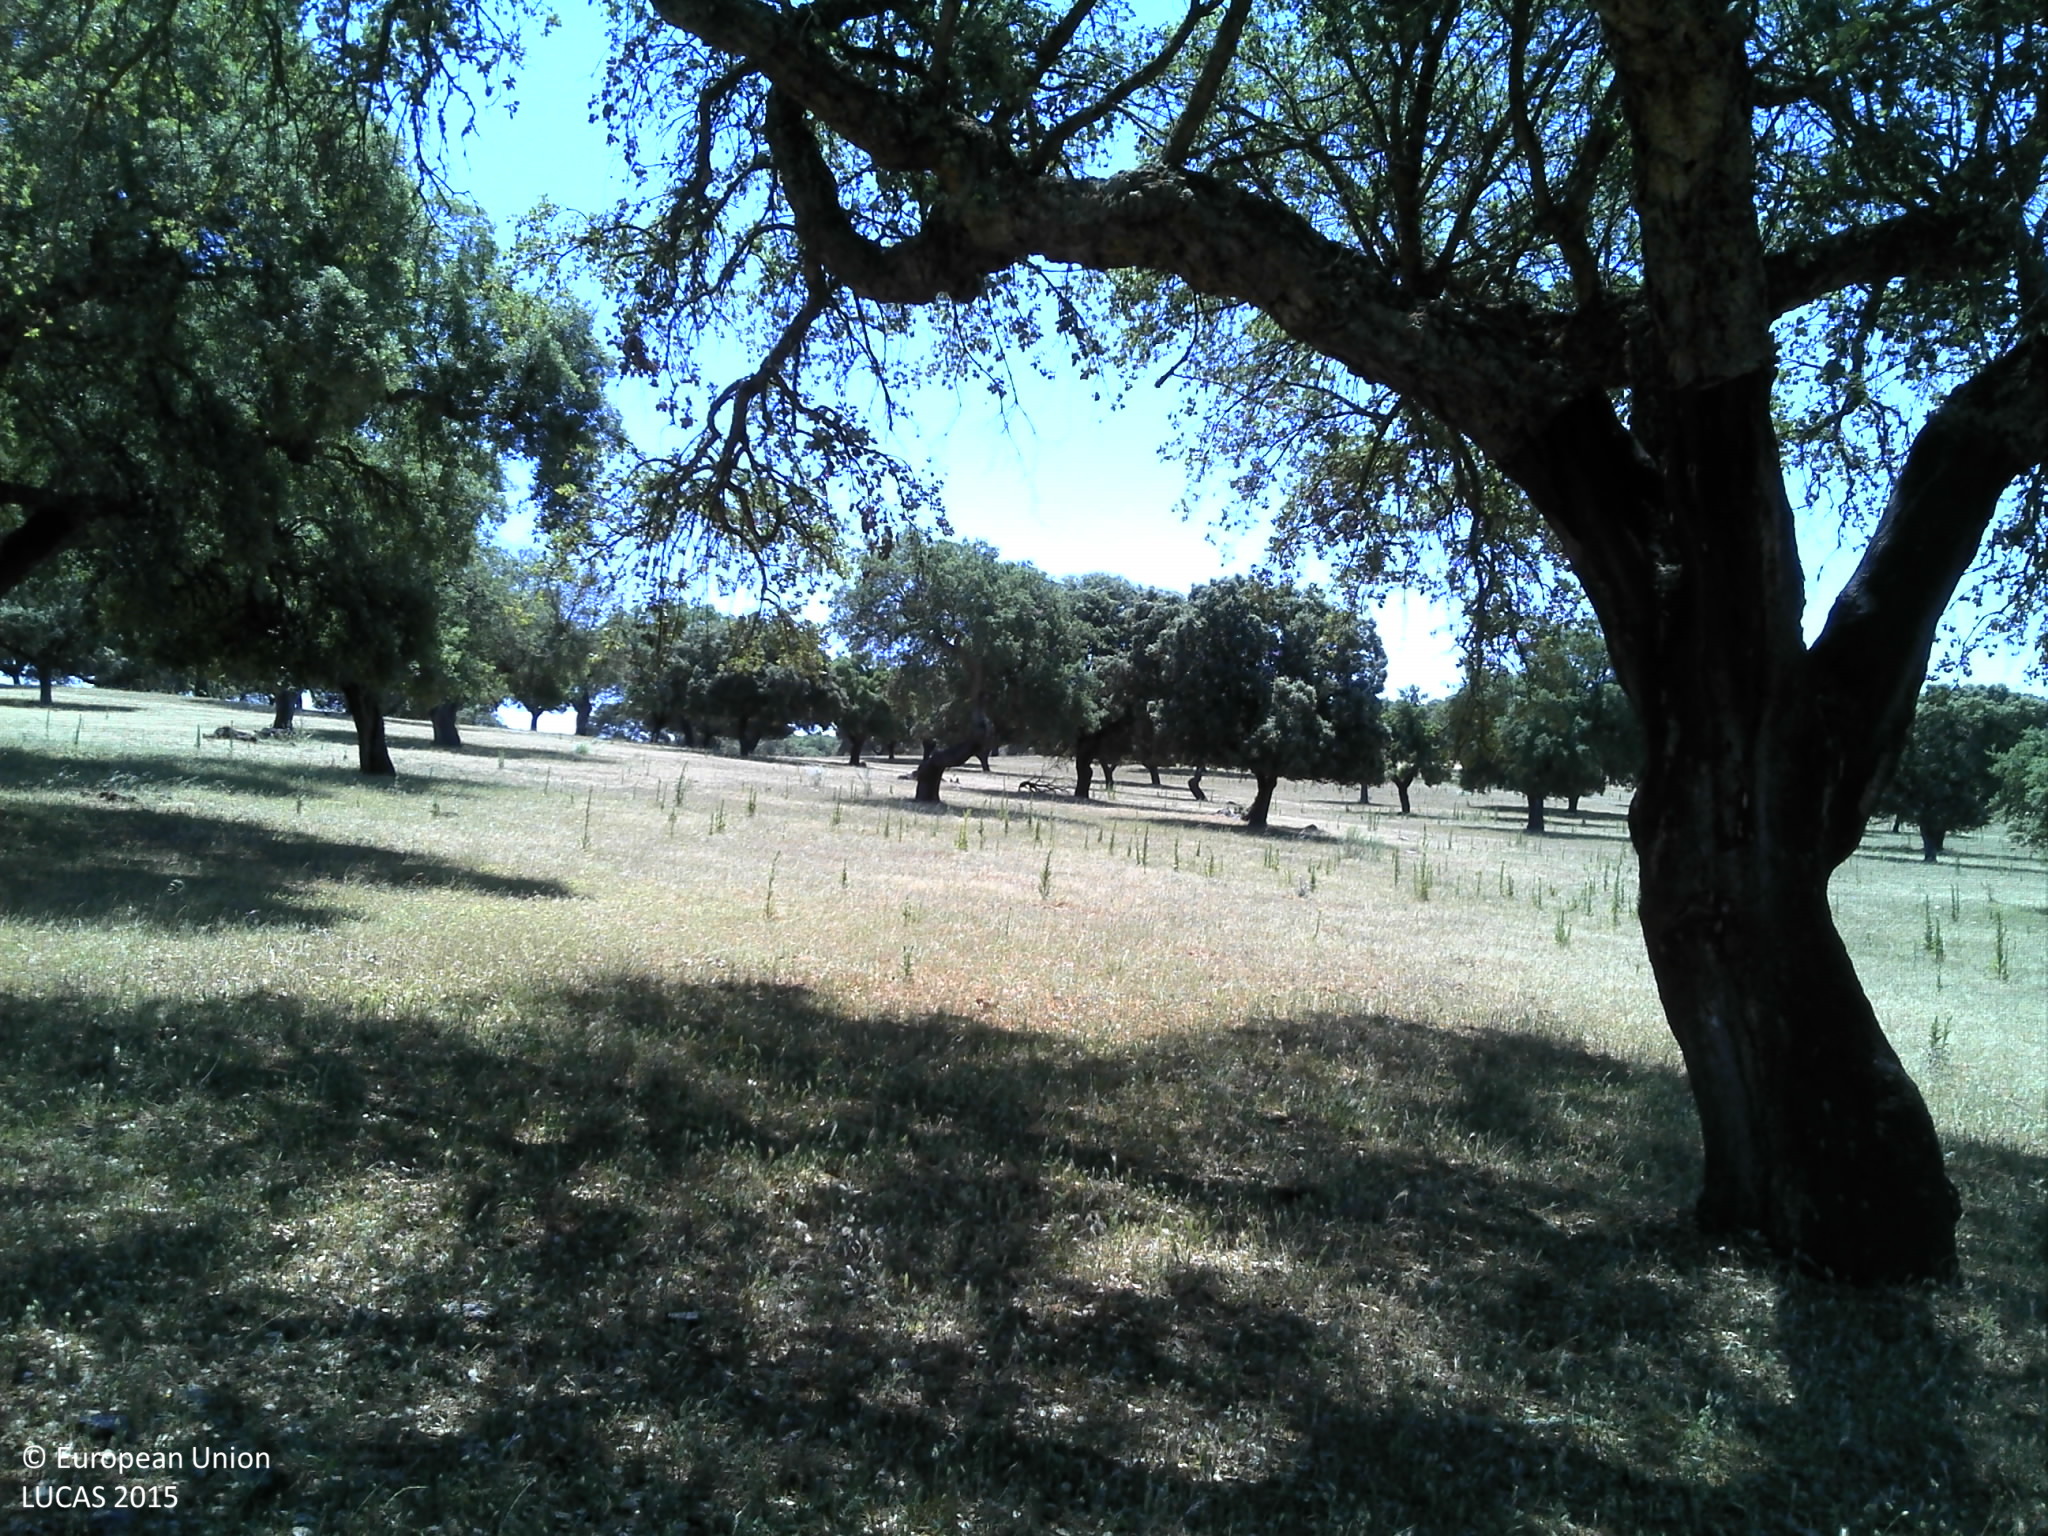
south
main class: Woodland
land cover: Broadleaved woodland
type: broadleaved evergreen forest
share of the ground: 25 - 50 %
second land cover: Grassland without tree/shrub cover
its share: 25 - 50 %
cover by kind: broadleaved forest trees 40 %, unconsolidated bare surface 35 %, herbaceous plants 25 %
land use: Forestry
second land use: Agriculture (excluding fallow land and kitchen gardens)
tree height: > 5 m
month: May
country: PT
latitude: 38.9550
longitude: -7.6141
